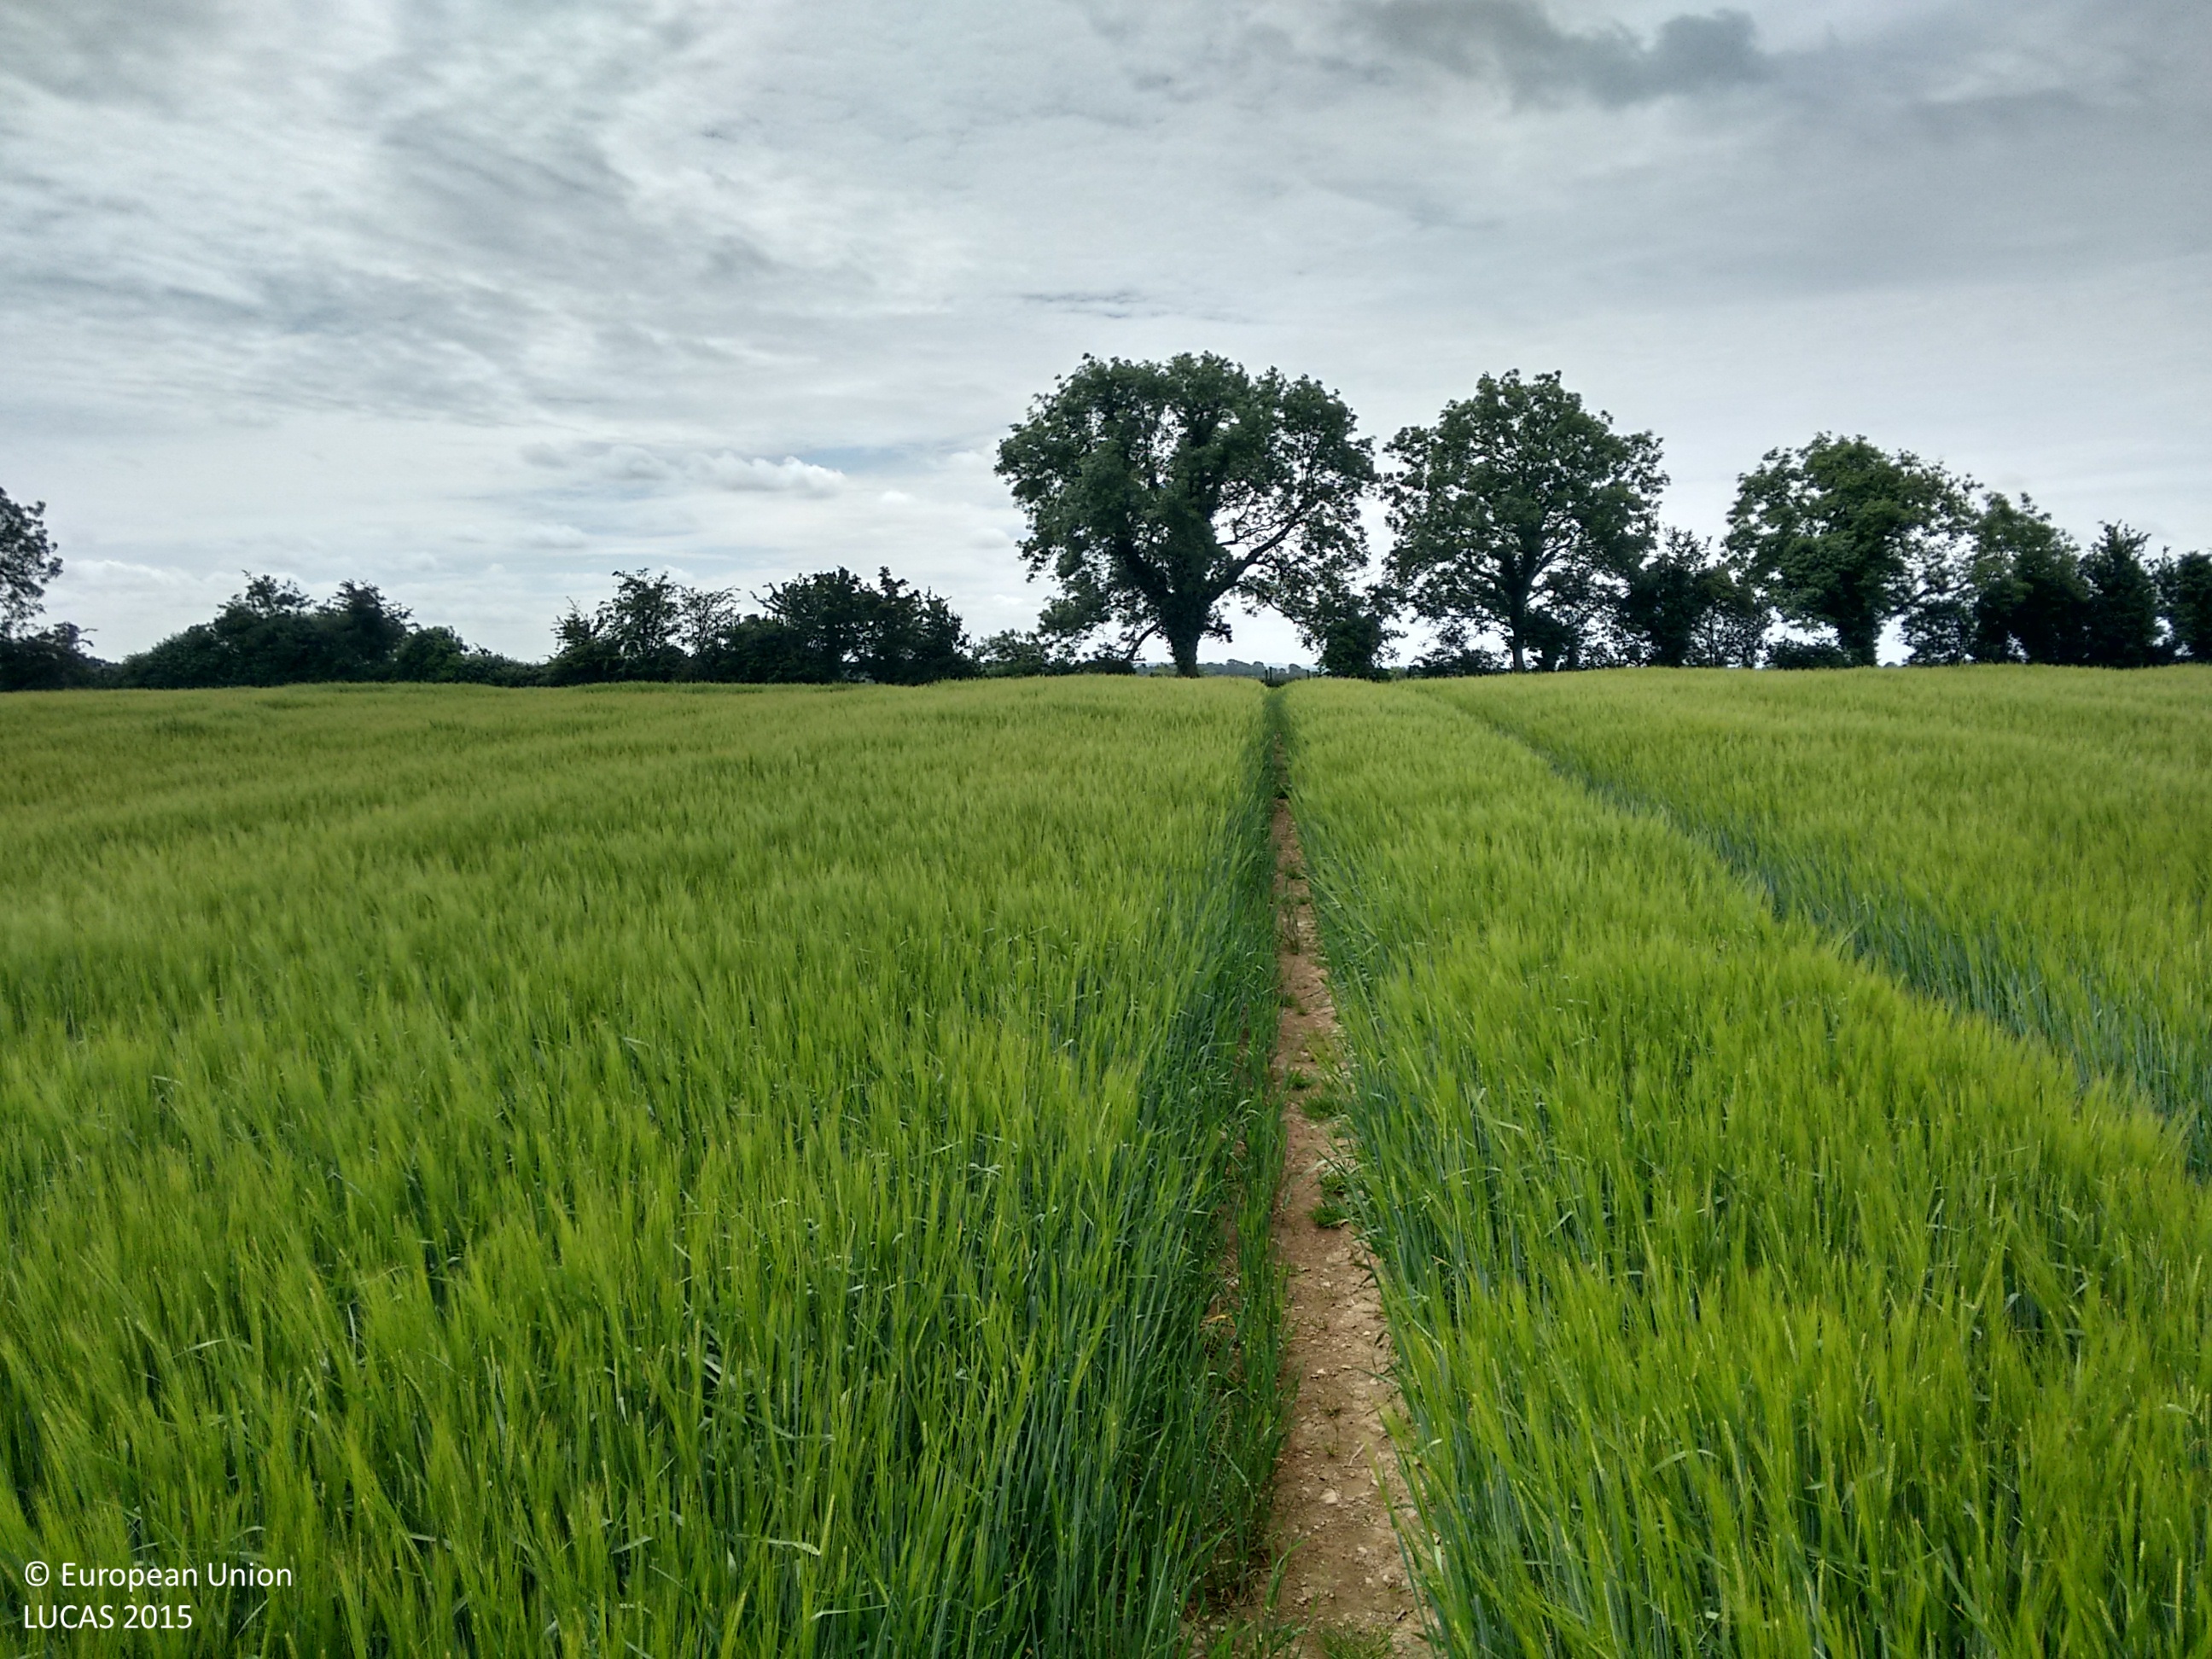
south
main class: Cropland
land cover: Barley
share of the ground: > 75 %
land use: Agriculture (excluding fallow land and kitchen gardens)
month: June
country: IE
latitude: 53.7285
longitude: -6.6364
